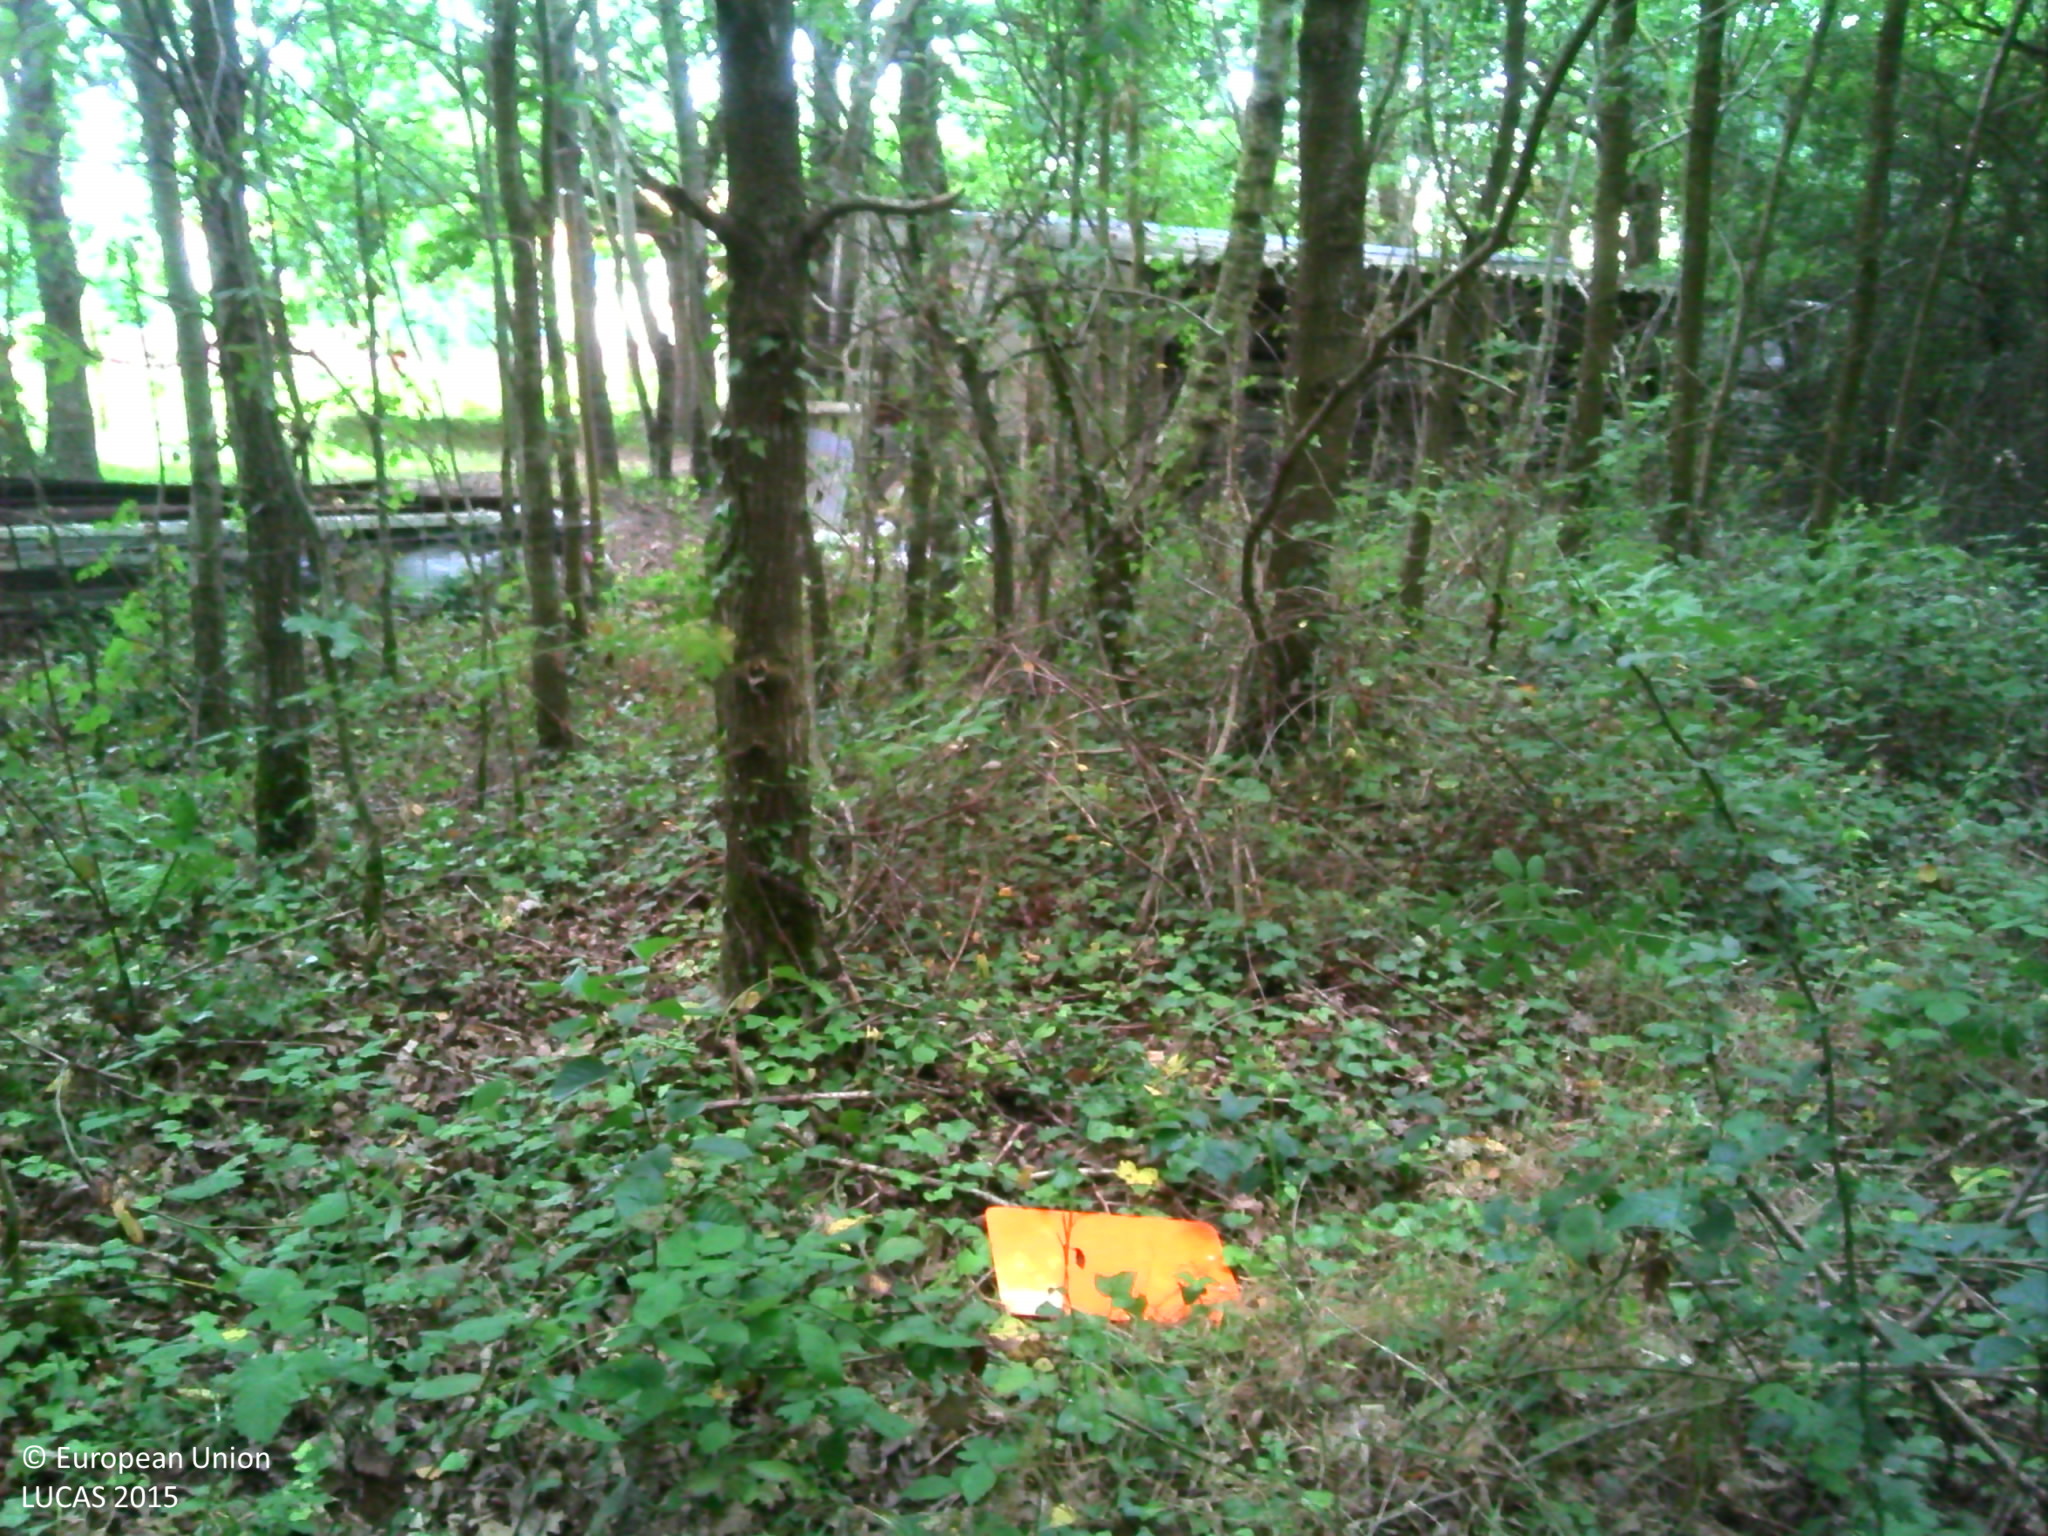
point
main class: Woodland
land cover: Broadleaved woodland
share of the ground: > 75 %
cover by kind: broadleaved forest trees 95 %, herbaceous plants 5 %
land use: Semi-natural and natural areas not in use
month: July
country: FR
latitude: 47.1215
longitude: -1.7356
